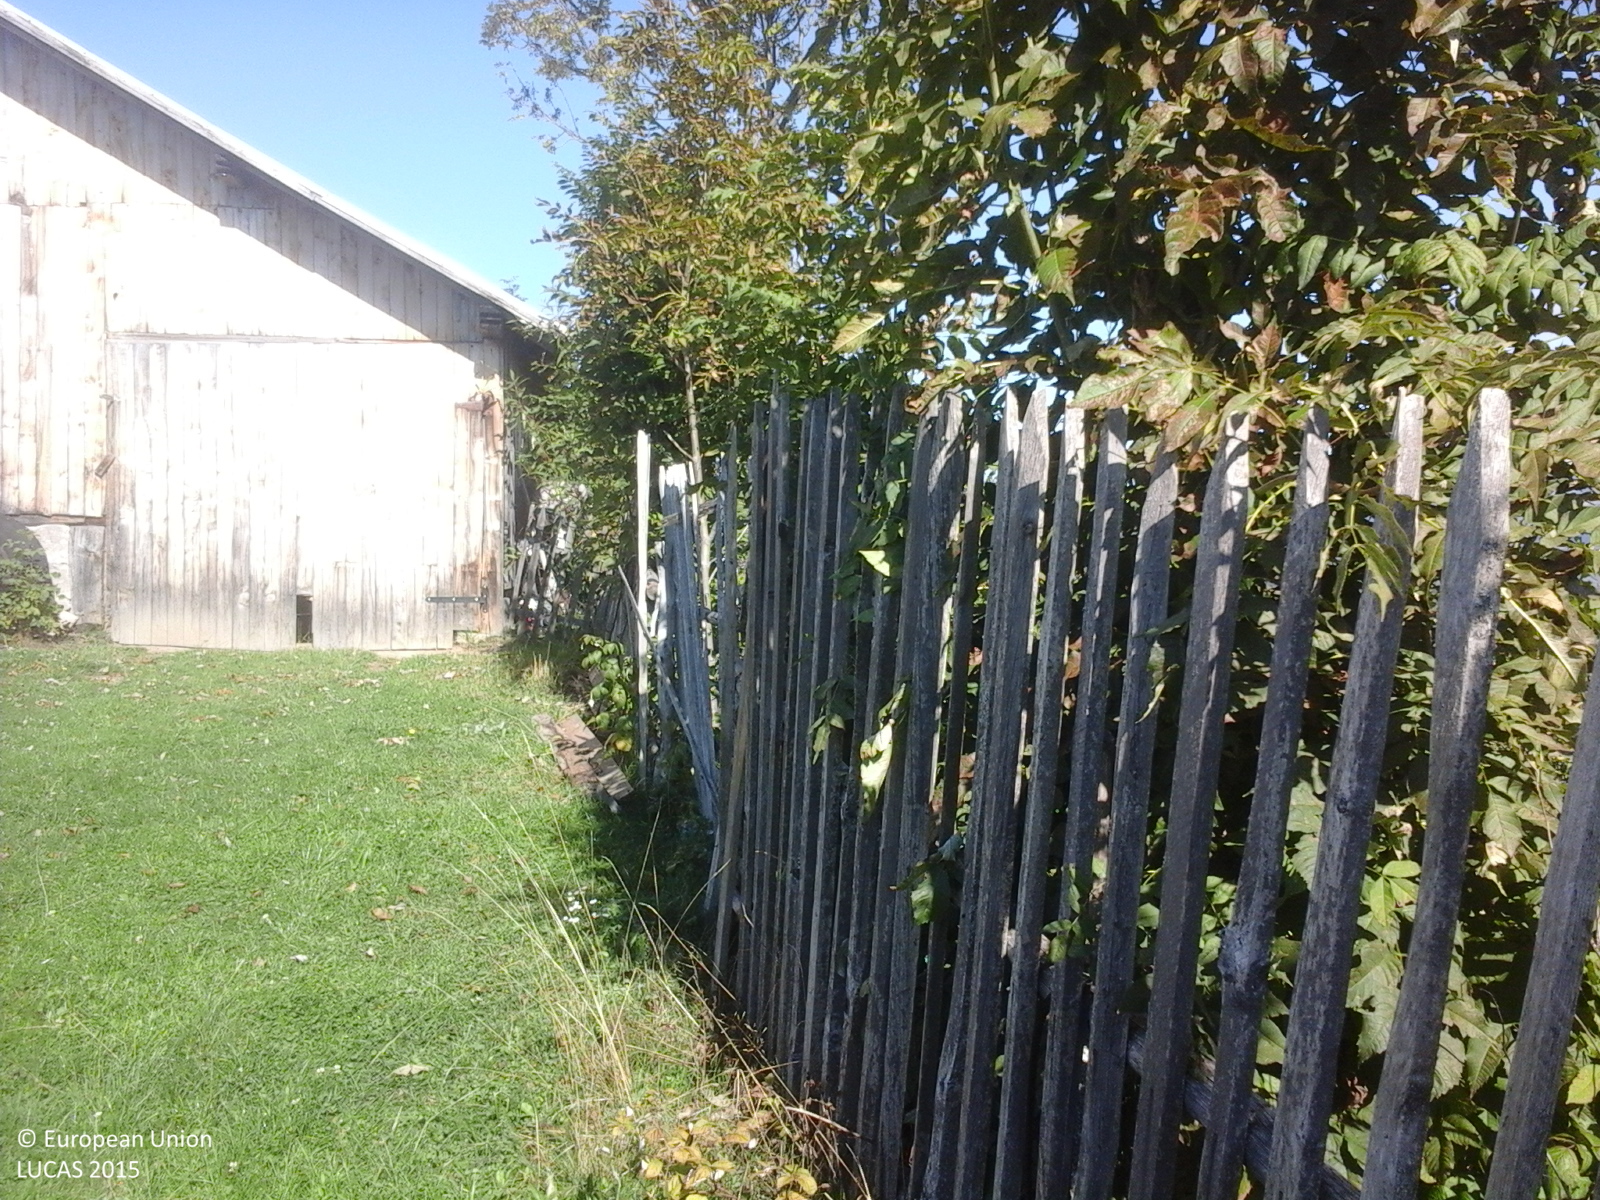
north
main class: Cropland
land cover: Apple fruit
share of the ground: > 75 %
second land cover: Grassland without tree/shrub cover
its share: > 75 %
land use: Agriculture (excluding fallow land and kitchen gardens)
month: October
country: RO
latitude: 46.4168
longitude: 22.9513
